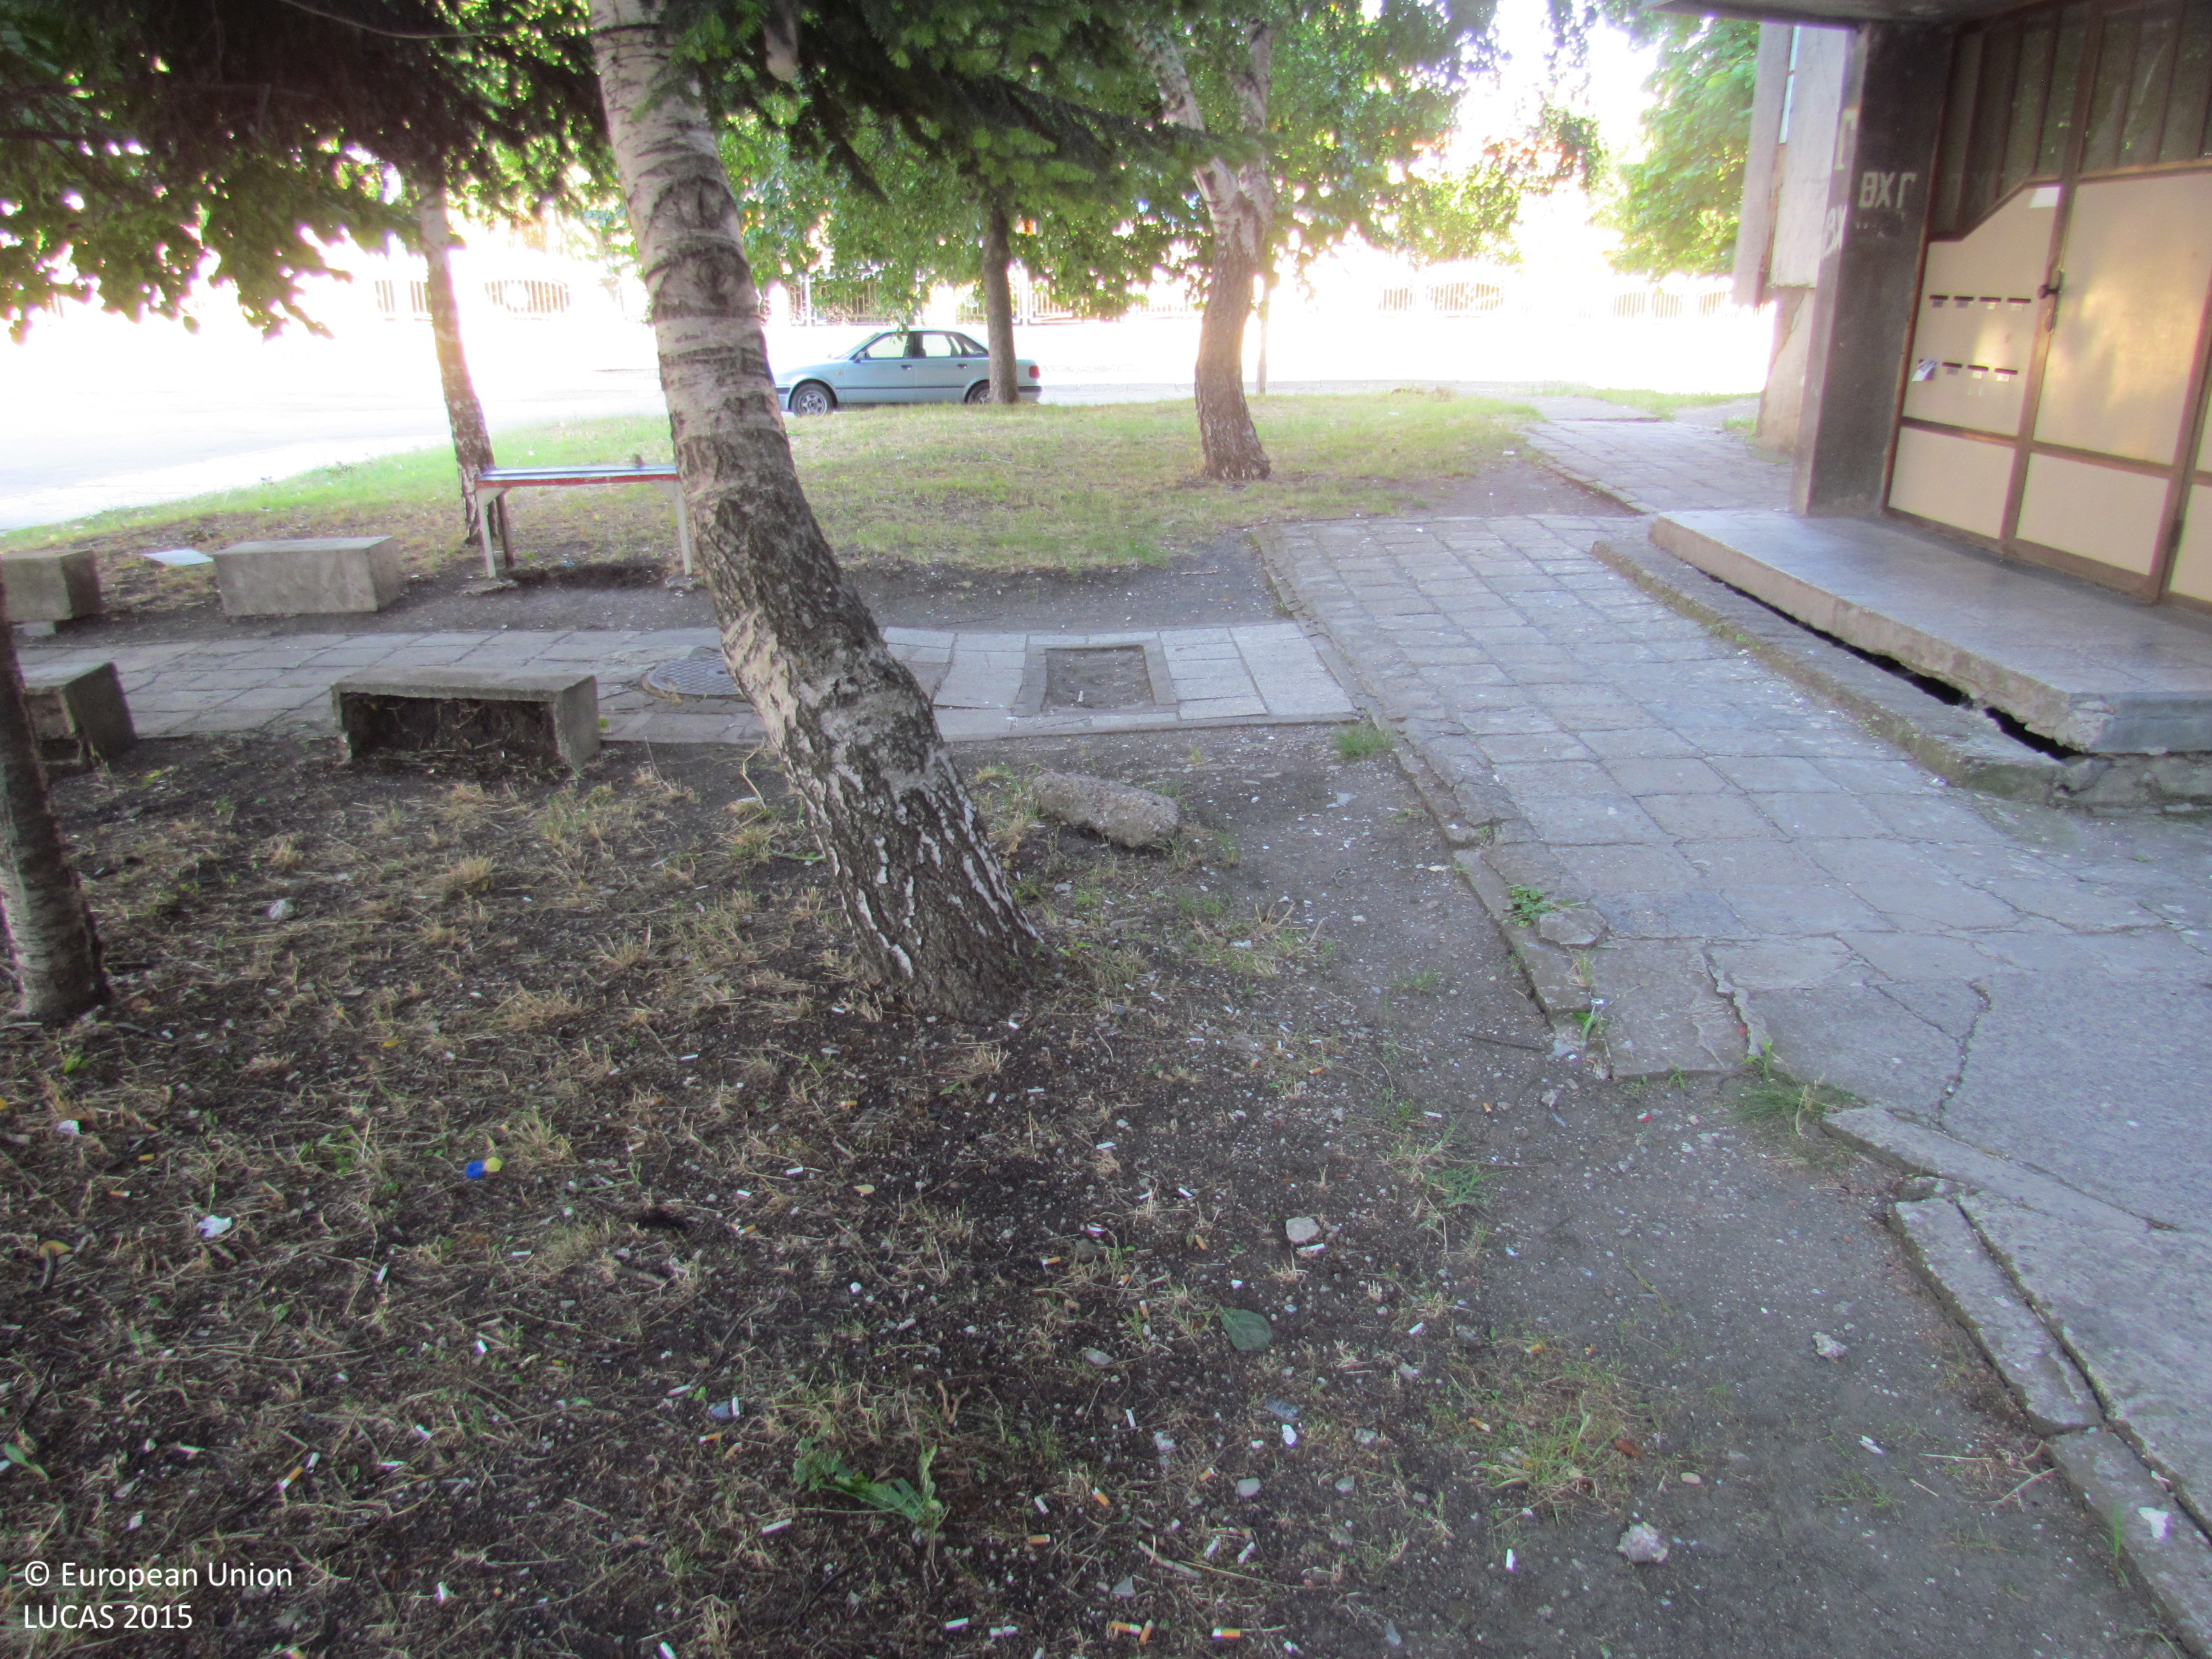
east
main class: Woodland
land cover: Broadleaved woodland
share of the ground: > 75 %
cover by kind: broadleaved forest trees 75 %, unconsolidated bare surface 15 %, herbaceous plants 10 %
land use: Residential
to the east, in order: Broadleaved woodland; Artificial constructions in urban areas
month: July
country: BG
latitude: 42.4579
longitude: 27.4193
